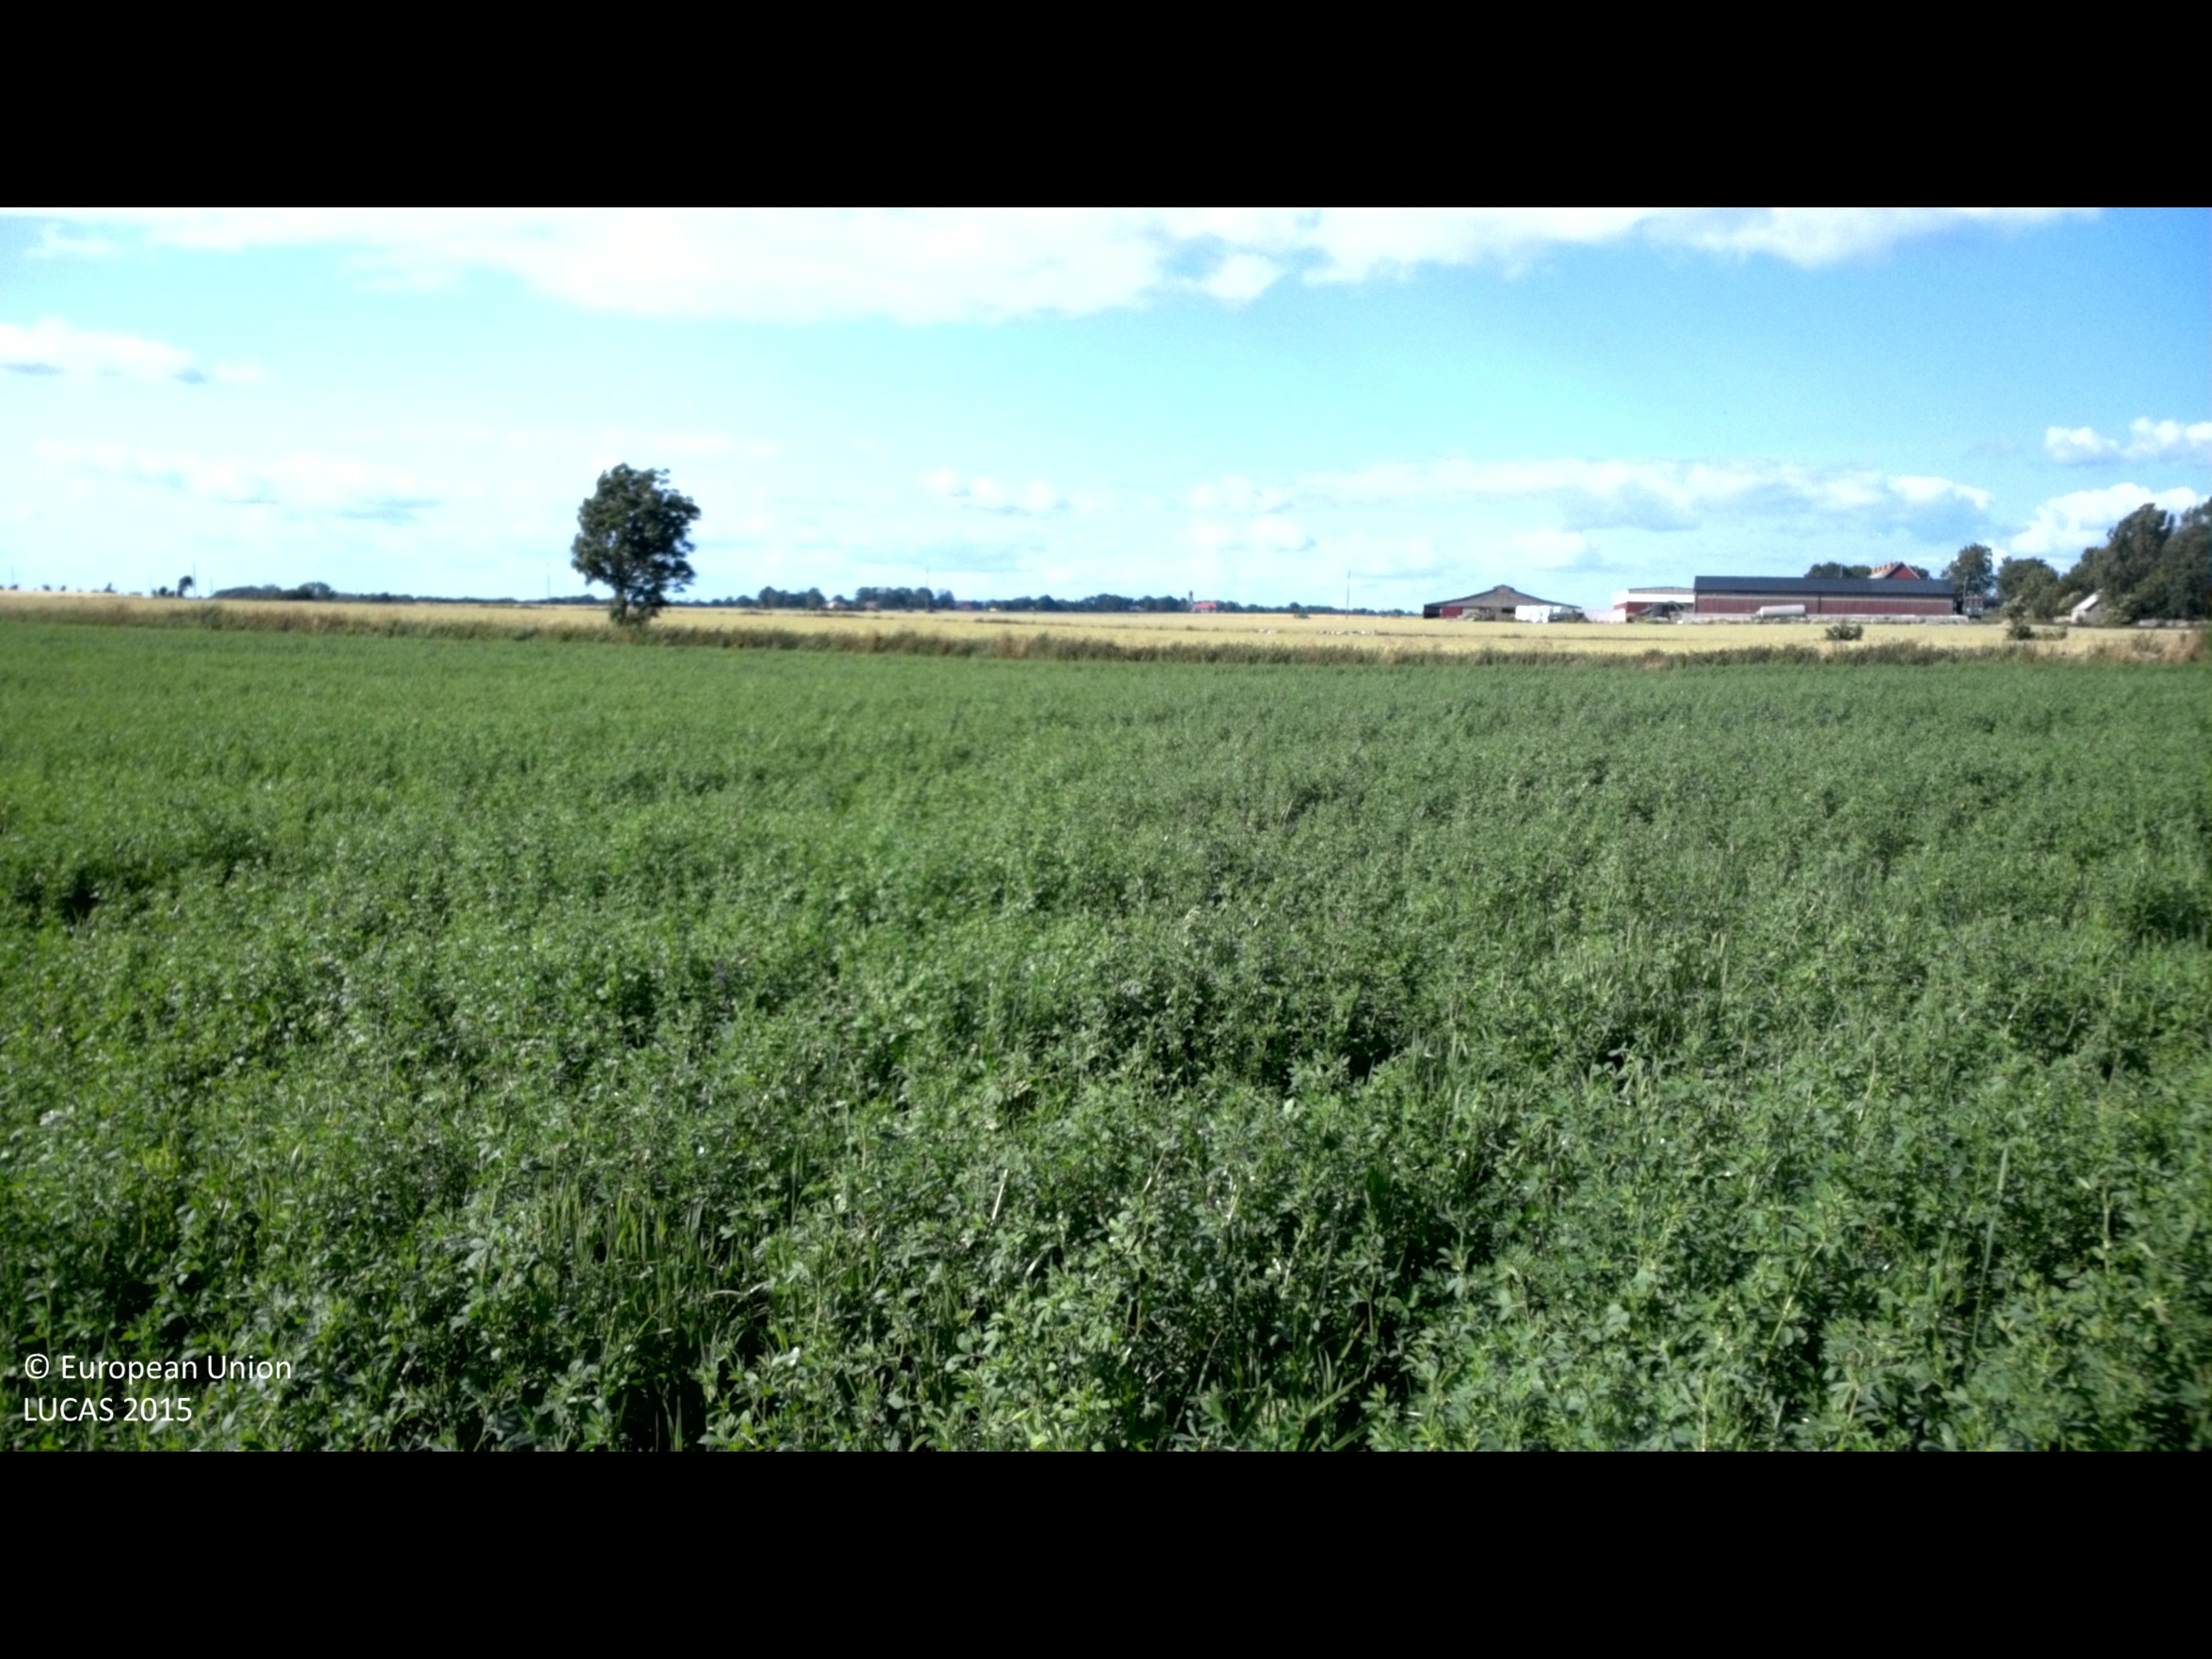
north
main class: Cropland
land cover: Lucerne
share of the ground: > 75 %
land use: Agriculture (excluding fallow land and kitchen gardens)
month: July
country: SE
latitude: 56.3873
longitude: 16.4321
